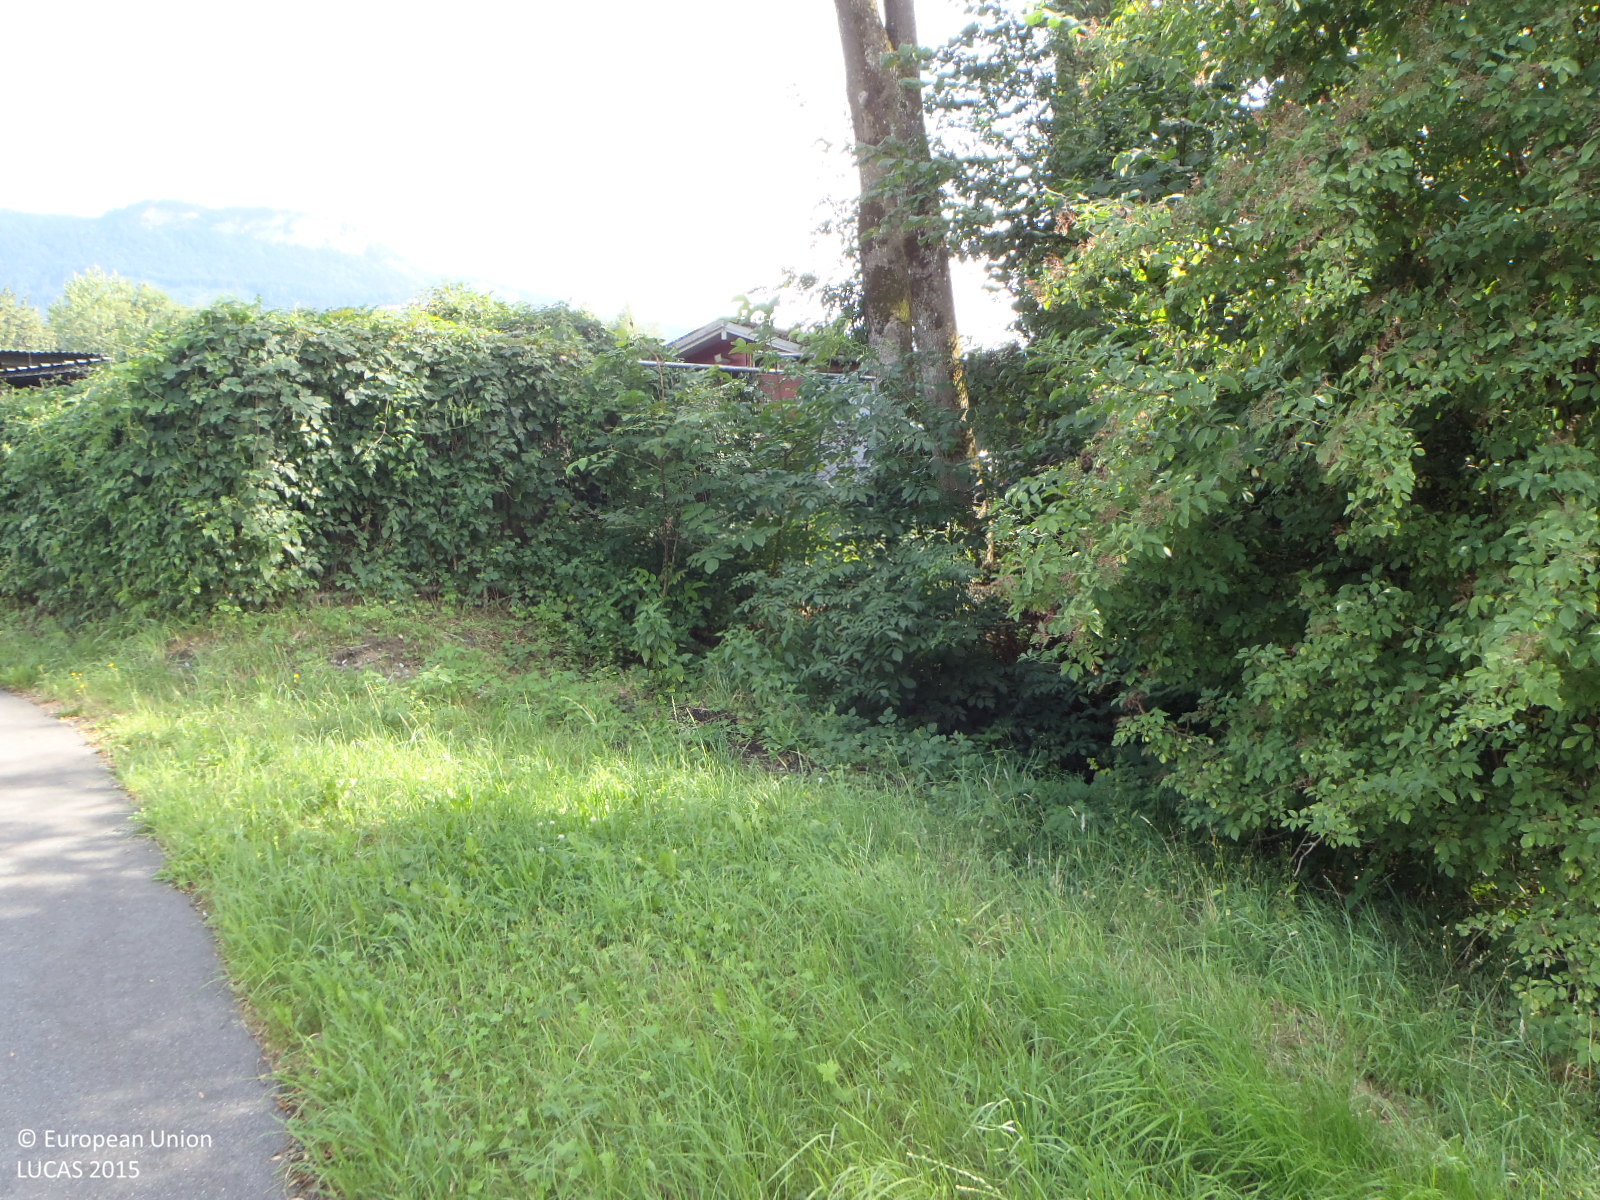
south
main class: Woodland
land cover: Other mixed woodland
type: alpine coniferous forest
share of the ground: > 75 %
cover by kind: coniferous forest trees 50 %, broadleaved forest trees 50 %
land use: Semi-natural and natural areas not in use
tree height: > 5 m
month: July
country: CH
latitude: 47.3771
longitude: 9.6692
